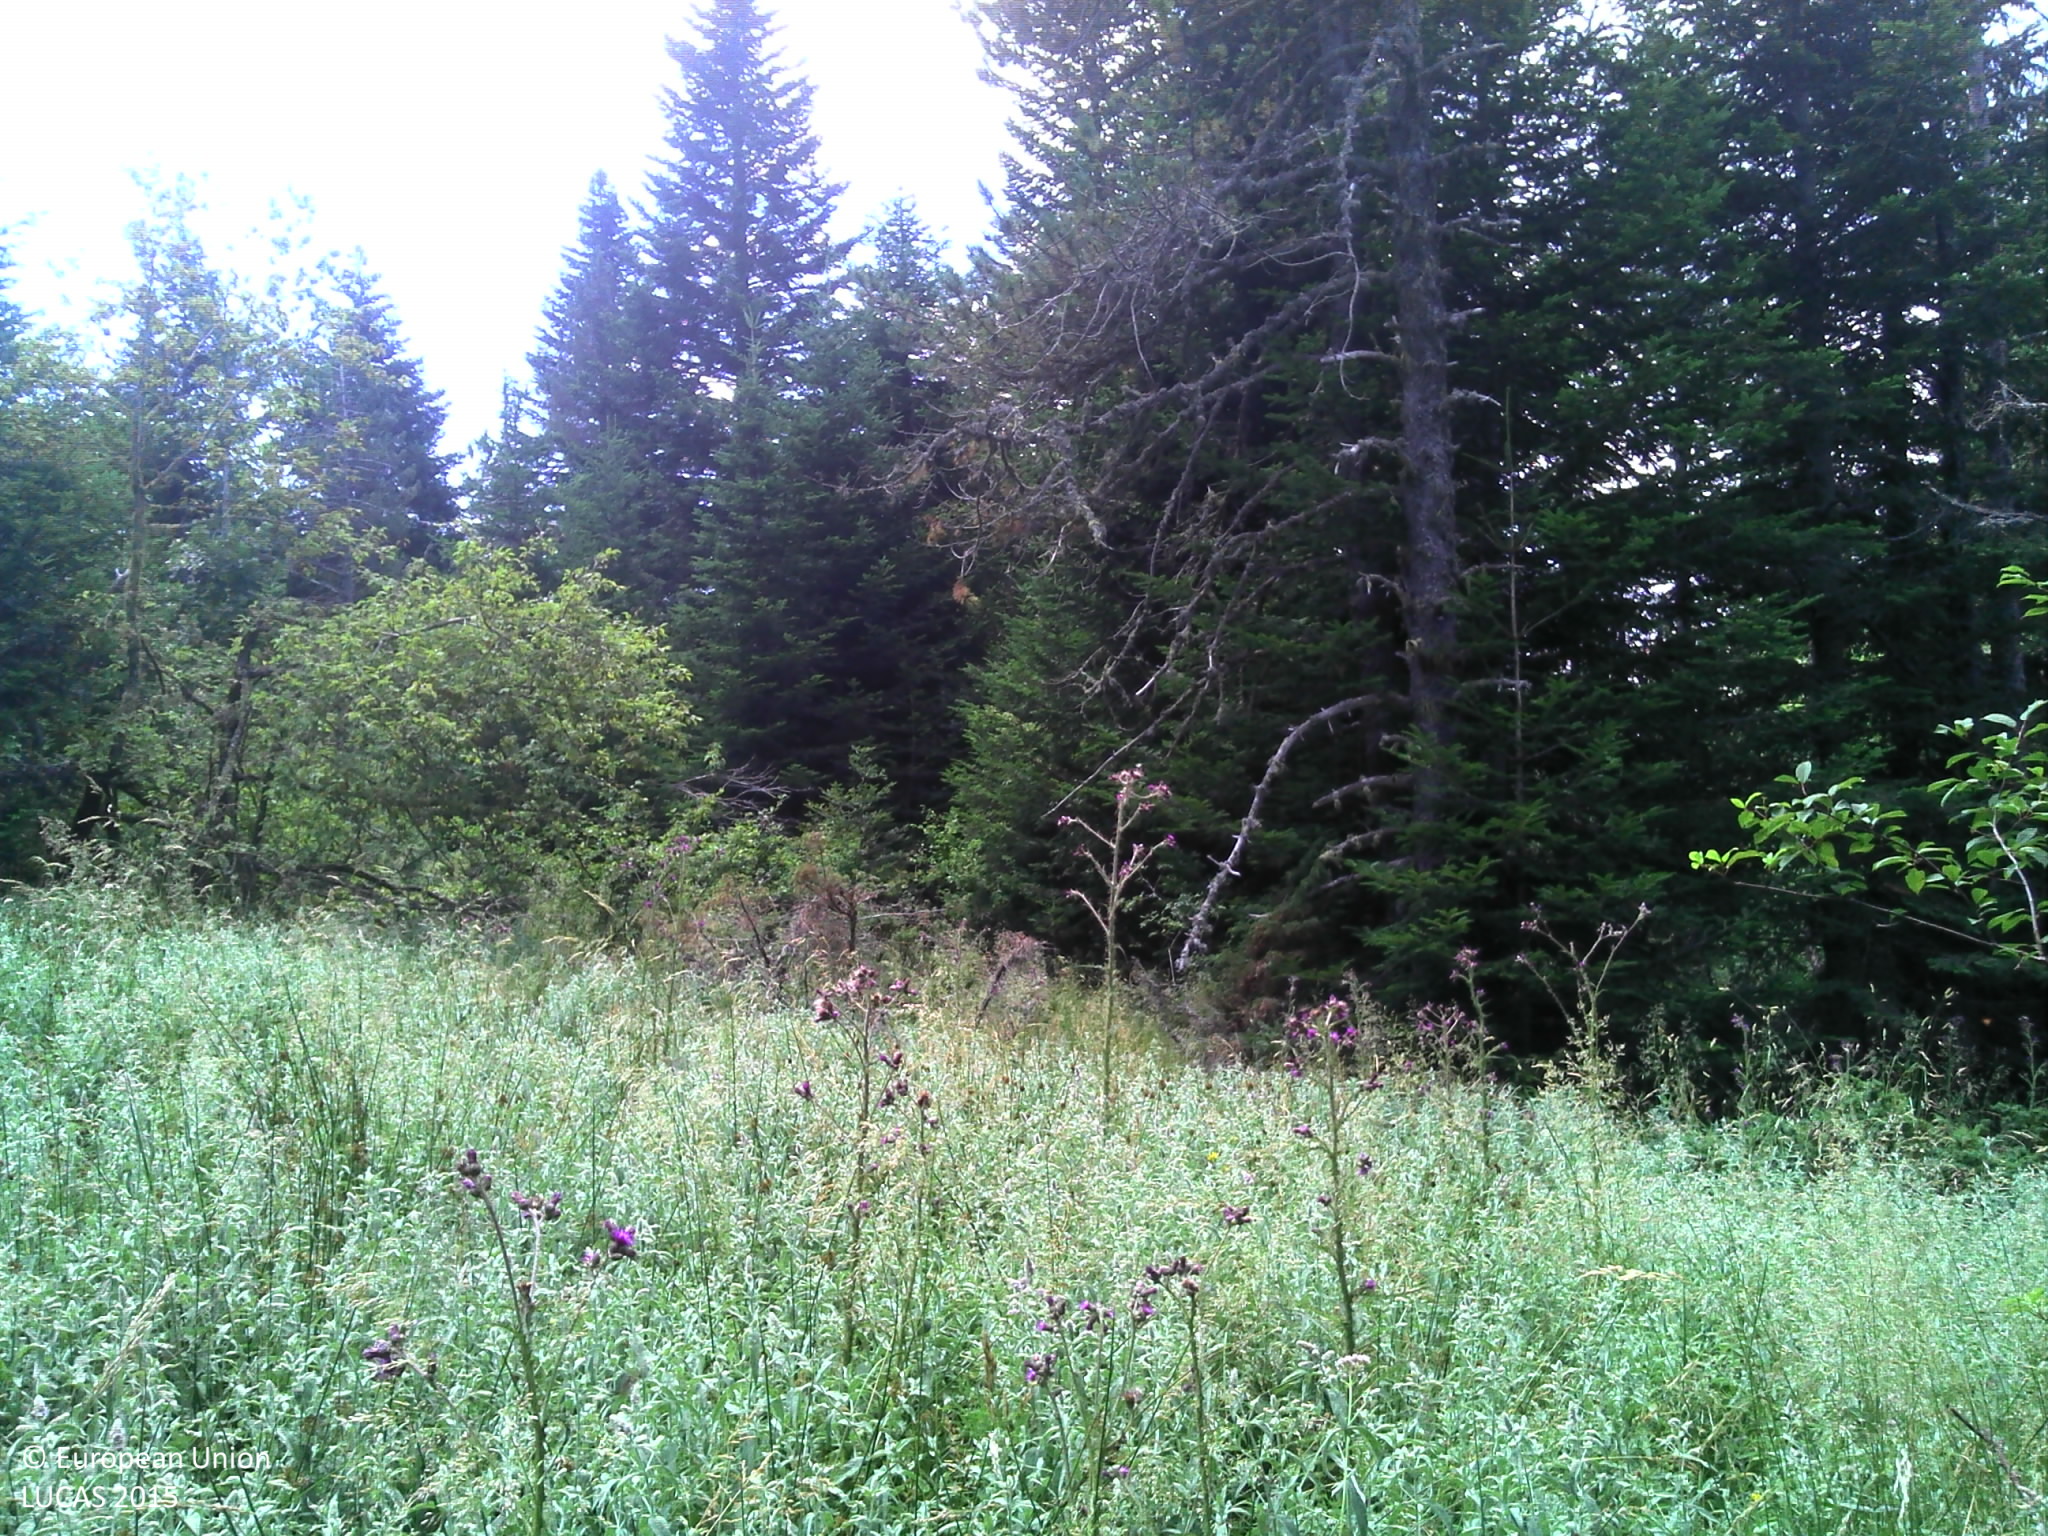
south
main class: Woodland
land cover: Other mixed woodland
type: alpine coniferous forest
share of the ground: > 75 %
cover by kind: herbaceous plants 55 %, coniferous forest trees 30 %, broadleaved forest trees 15 %
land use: Forestry
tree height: > 5 m
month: July
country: FR
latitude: 42.6567
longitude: 2.1421
